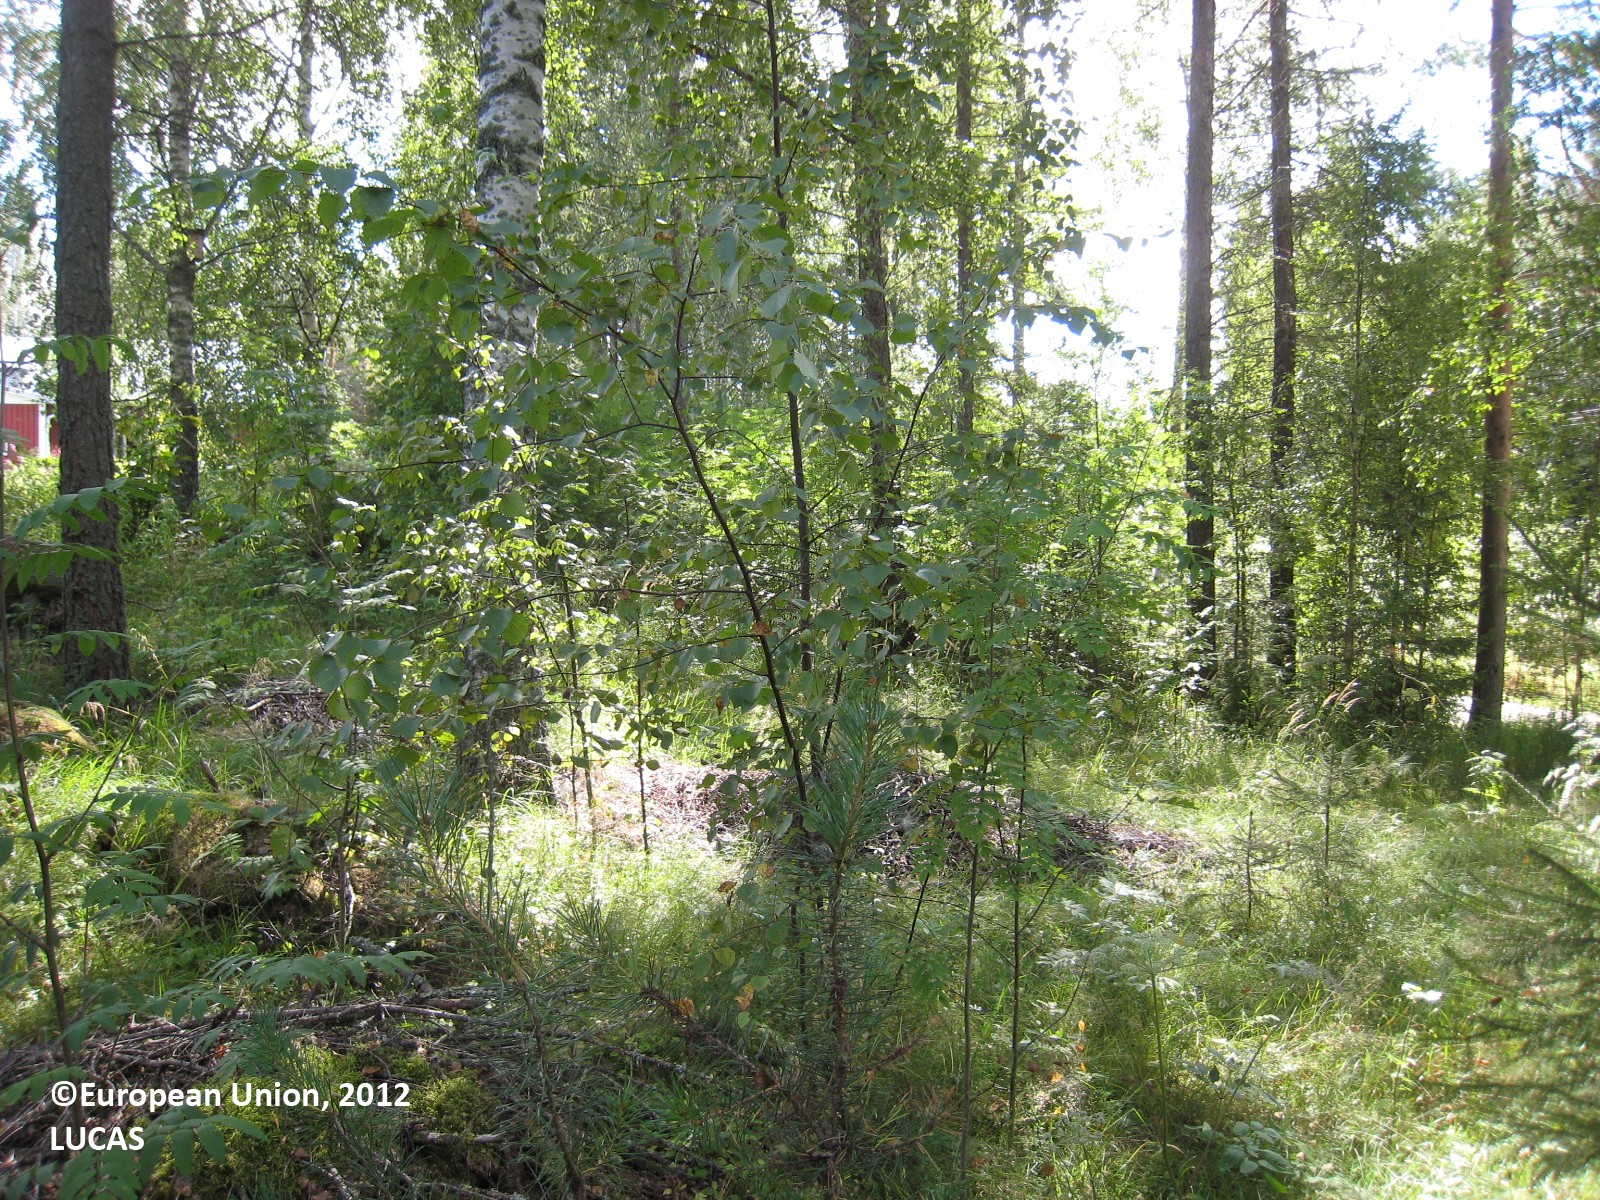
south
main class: Woodland
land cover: Other mixed woodland
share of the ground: 50 - 75 %
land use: Semi-natural and natural areas not in use
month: August
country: FI
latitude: 61.9460
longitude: 27.1838
